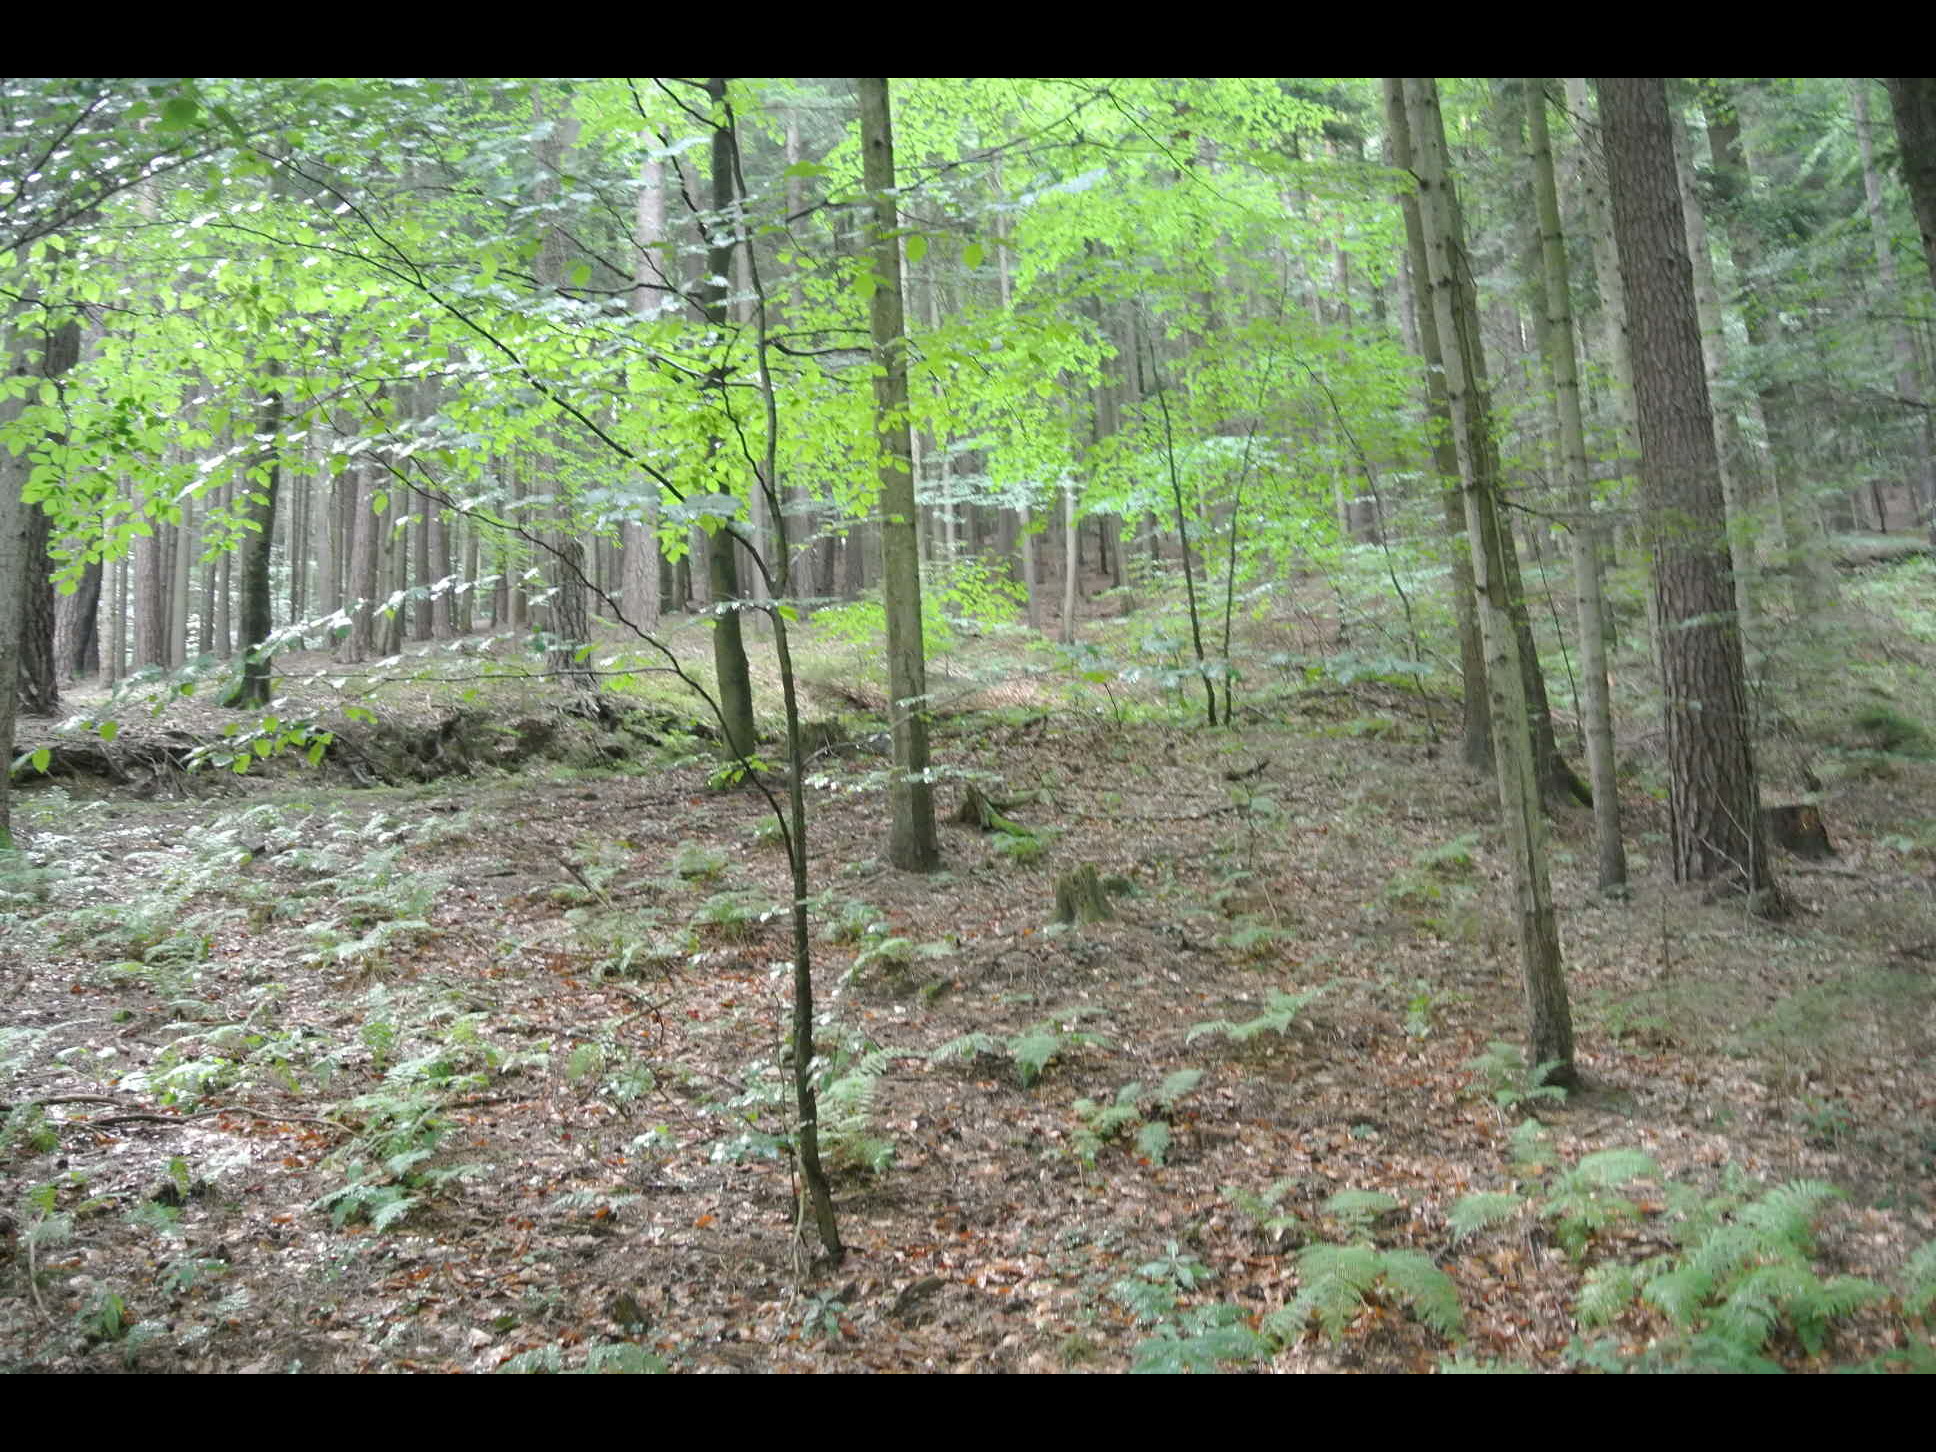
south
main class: Woodland
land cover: Spruce dominated coniferous woodland
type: alpine coniferous forest
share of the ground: > 75 %
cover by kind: coniferous forest trees 75 %, broadleaved forest trees 20 %, herbaceous plants 5 %
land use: Forestry
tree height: > 5 m
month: July
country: AT
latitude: 47.6209
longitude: 16.1101
